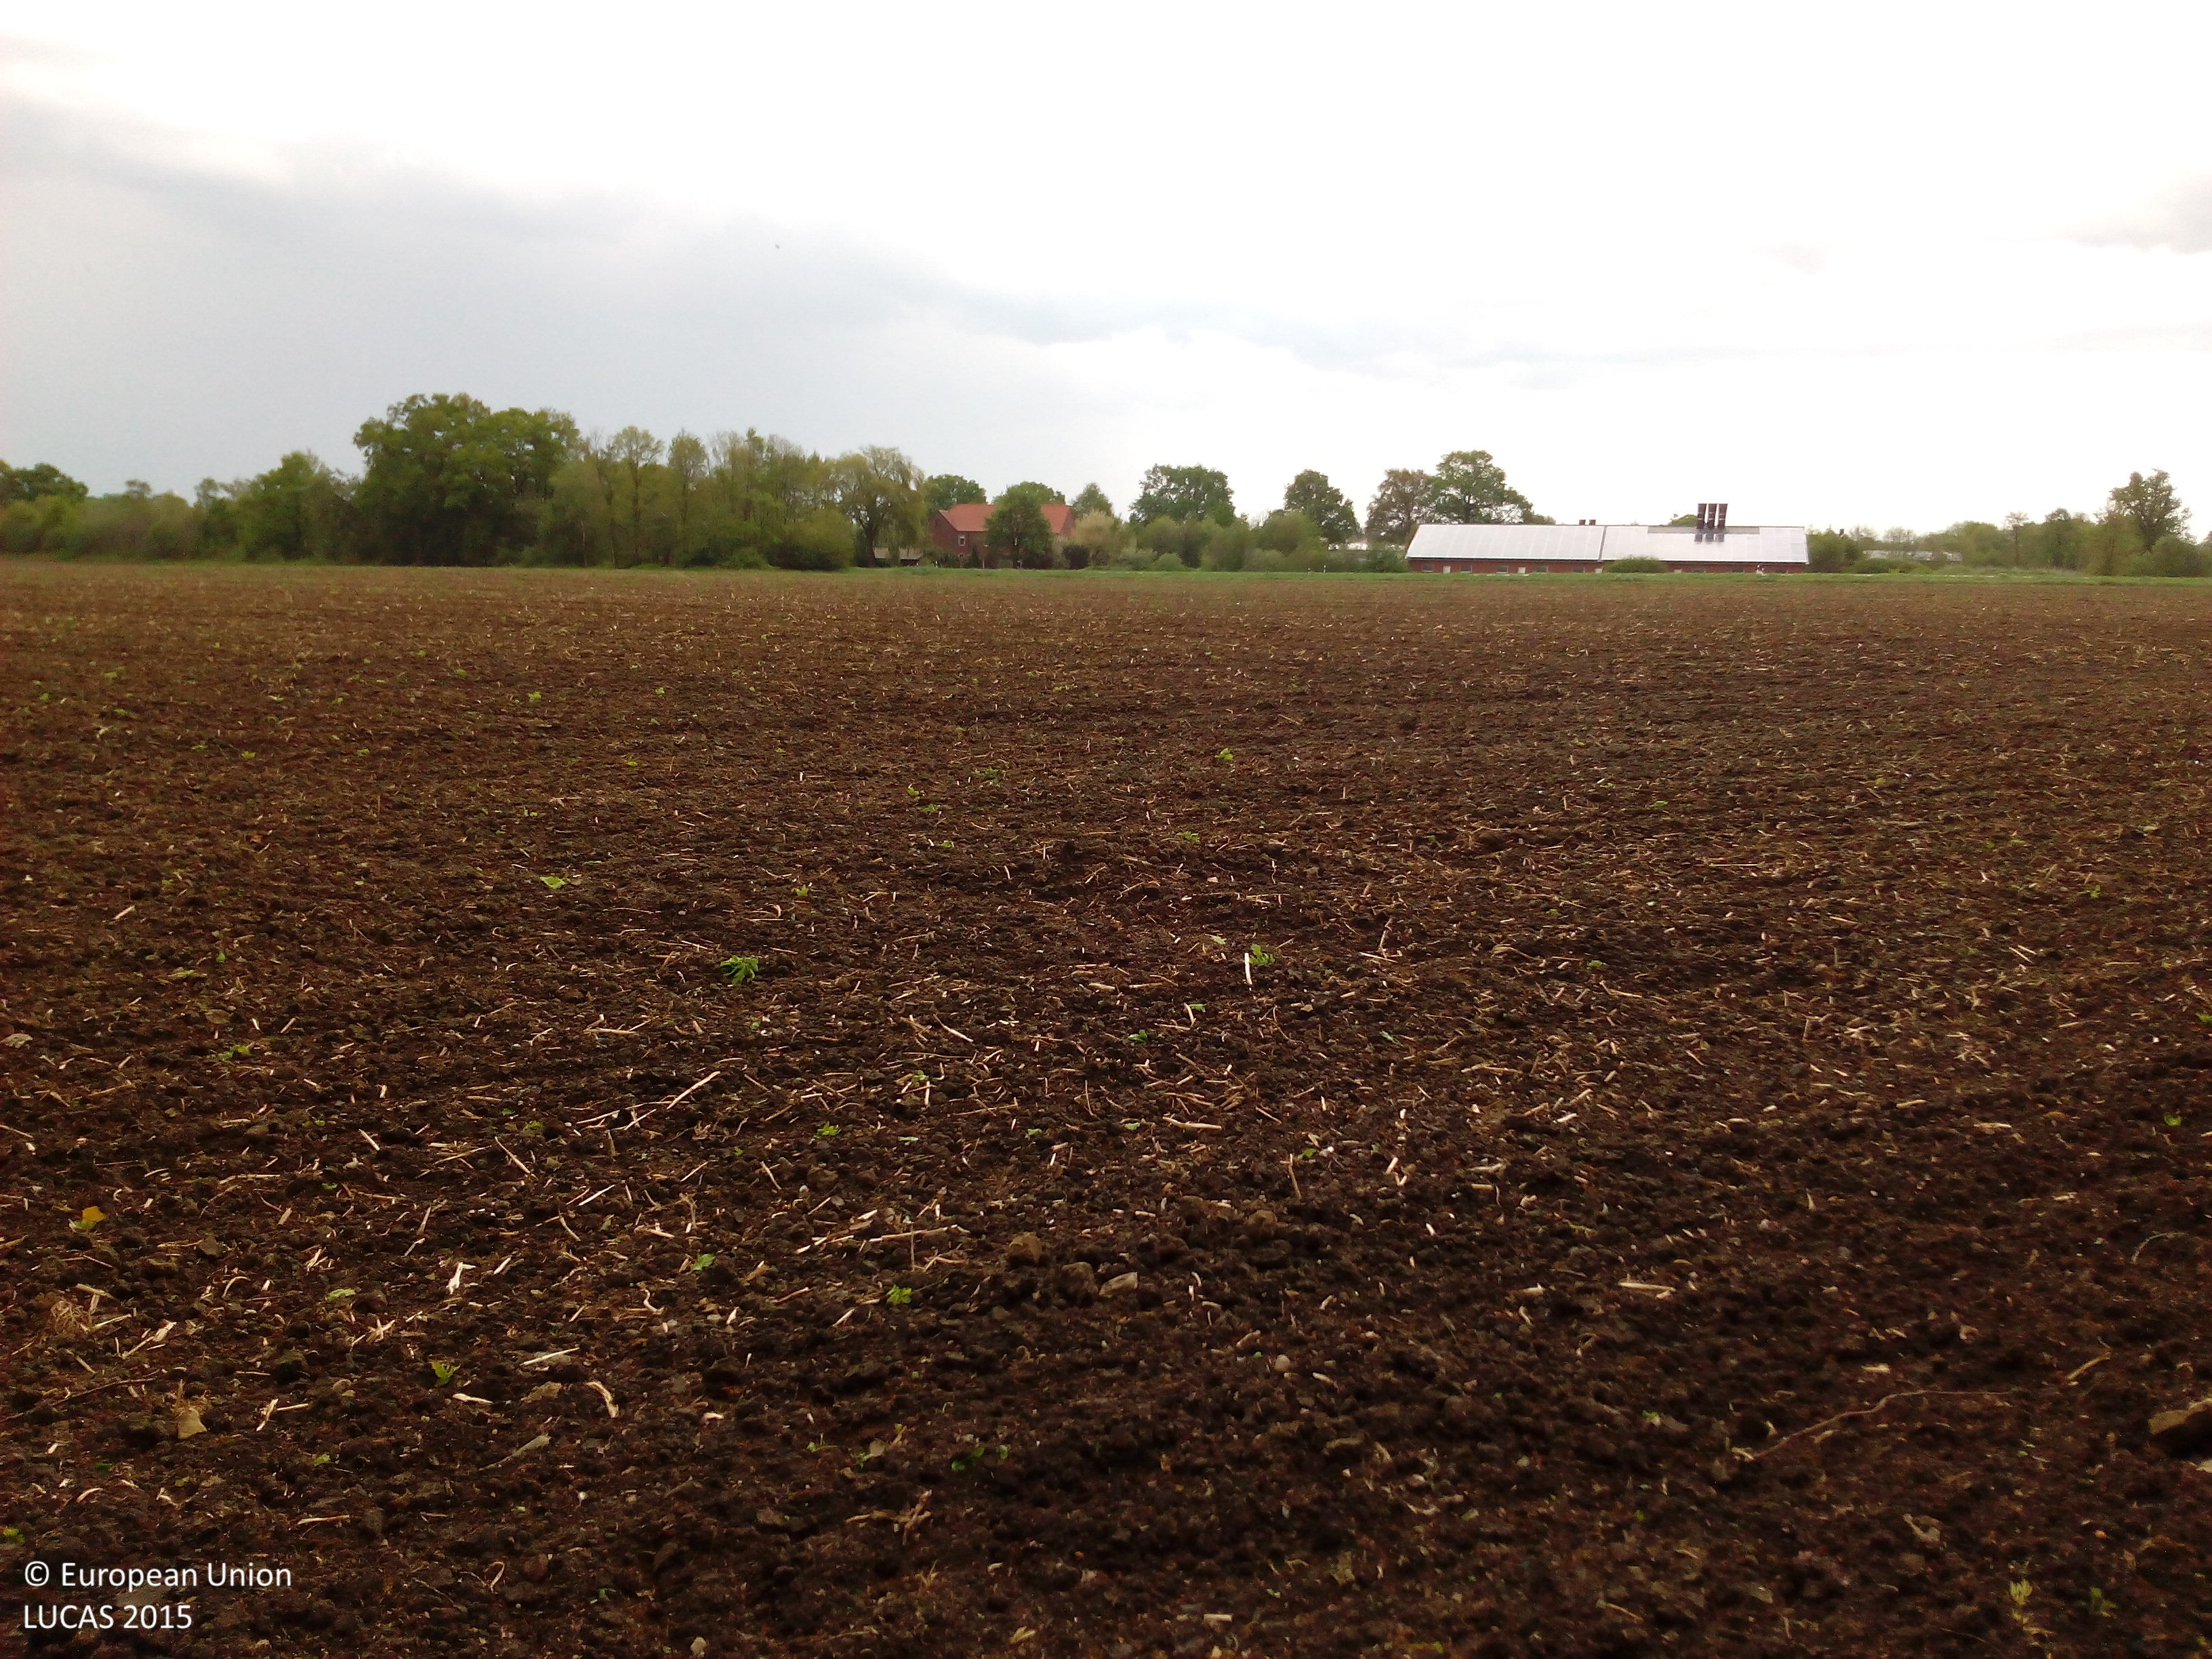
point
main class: Cropland
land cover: Maize
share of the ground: < 10 %
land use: Agriculture (excluding fallow land and kitchen gardens)
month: May
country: DE
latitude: 52.0623
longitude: 7.4477
